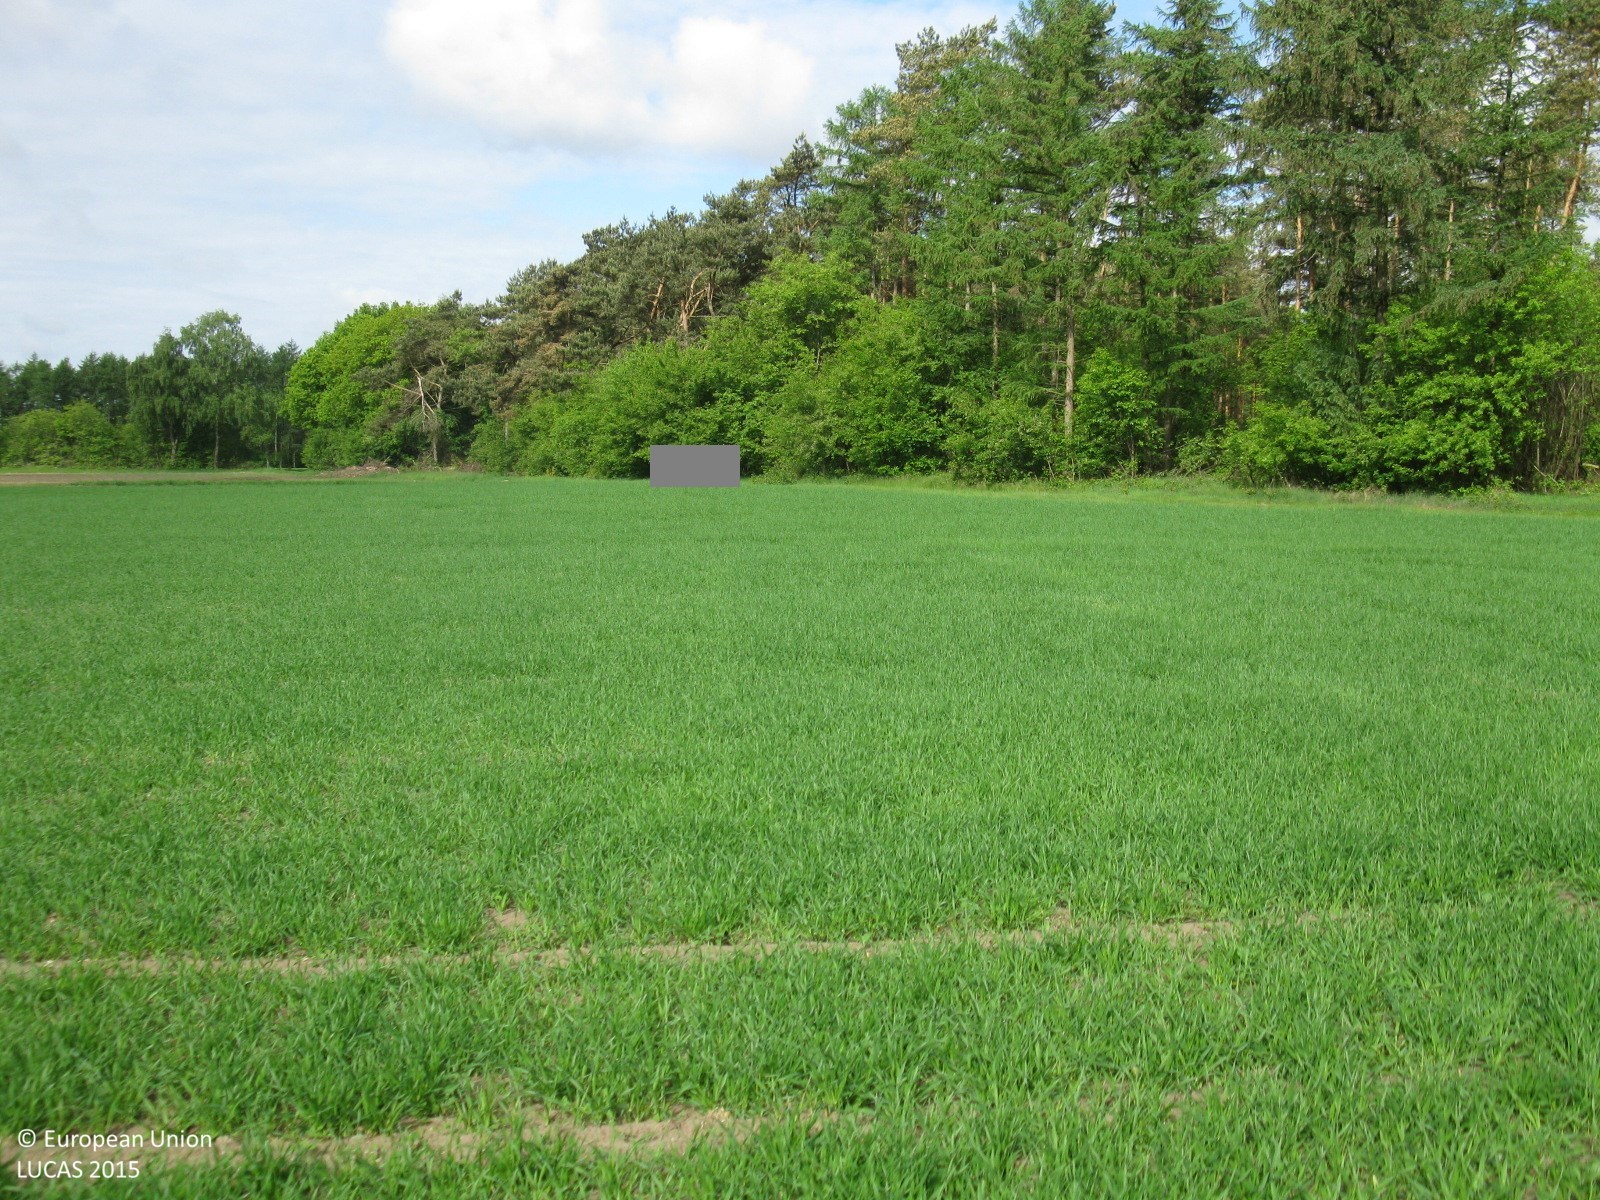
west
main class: Cropland
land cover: Barley
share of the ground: > 75 %
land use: Agriculture (excluding fallow land and kitchen gardens)
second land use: Community services
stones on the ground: < 10 %
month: May
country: DE
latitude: 52.8173
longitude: 7.4335
